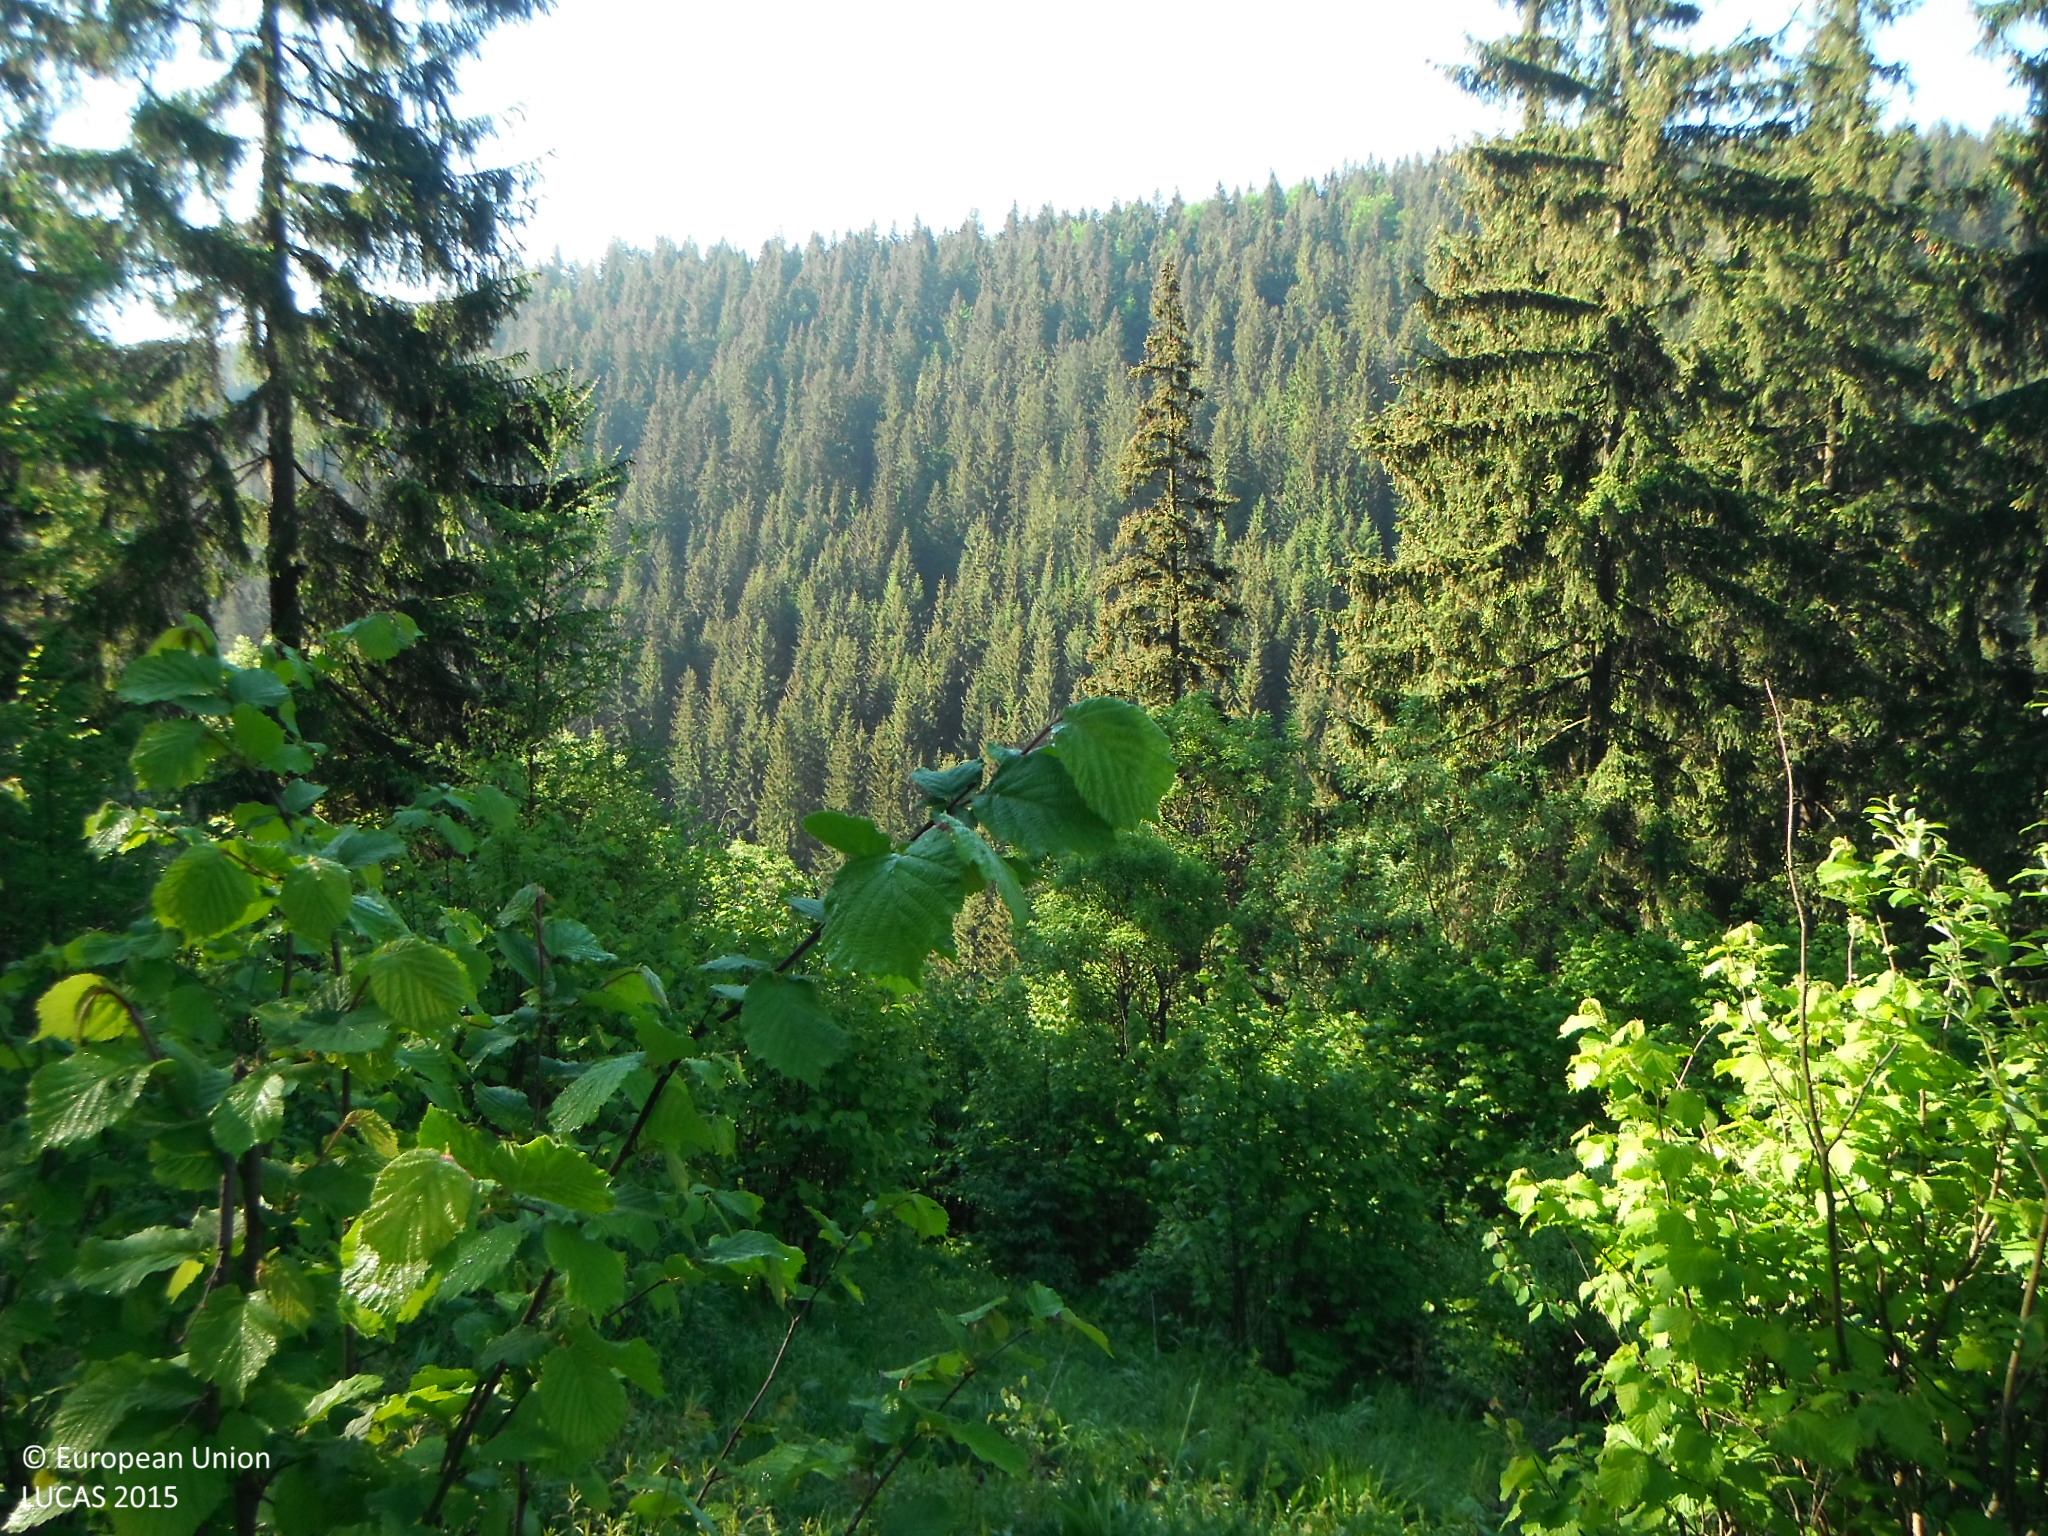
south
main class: Shrubland
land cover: Shrubland with sparse tree cover
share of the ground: > 75 %
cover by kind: shrubs 60 %, herbaceous plants 35 %, coniferous forest trees 5 %
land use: Forestry
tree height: > 5 m
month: June
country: SK
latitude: 49.0591
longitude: 19.9520
